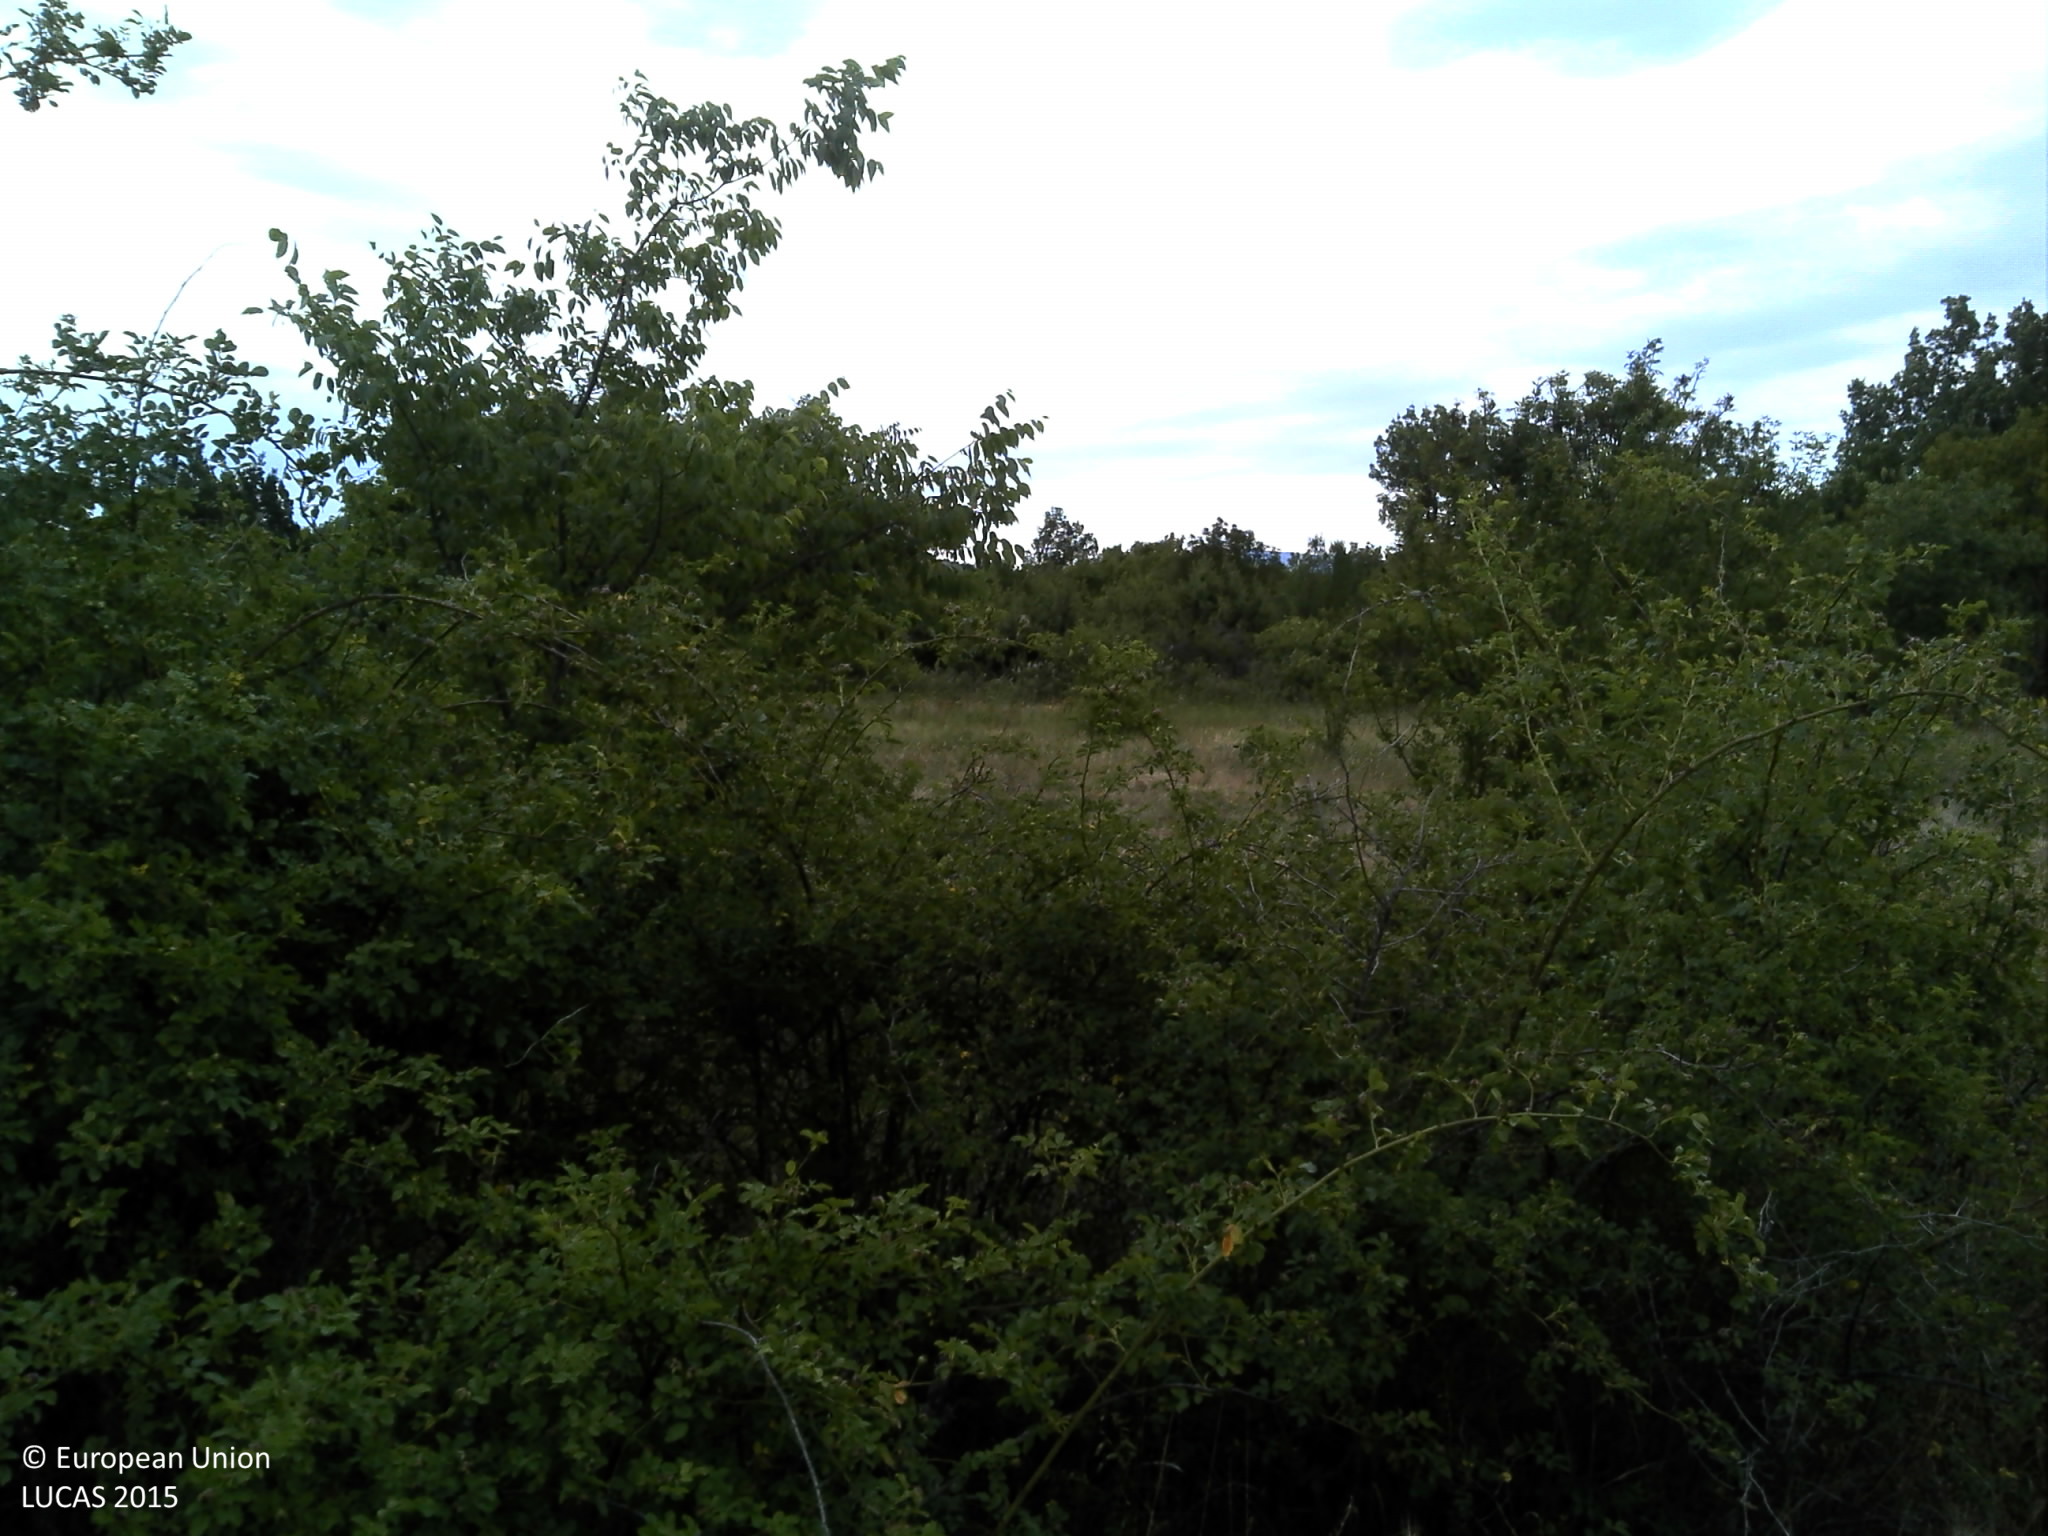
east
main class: Shrubland
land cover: Shrubland with sparse tree cover
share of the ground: 50 - 75 %
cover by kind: shrubs 50 %, herbaceous plants 45 %, broadleaved forest trees 5 %
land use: Fallow land
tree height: < 5 m
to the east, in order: Shrubland with sparse tree cover; Grassland without tree/shrub cover; Shrubland with sparse tree cover; Dry stone walls; Shrubland with sparse tree cover; Broadleaved woodland; Artificial constructions in urban areas; Dry stone walls; Grassland with sparse tree/shrub cover; Dry stone walls; Grassland with sparse tree/shrub cover; Dry stone walls; Shrubland with sparse tree cover; Dry stone walls; Shrubland with sparse tree cover
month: June
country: HR
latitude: 44.0613
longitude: 16.1220
